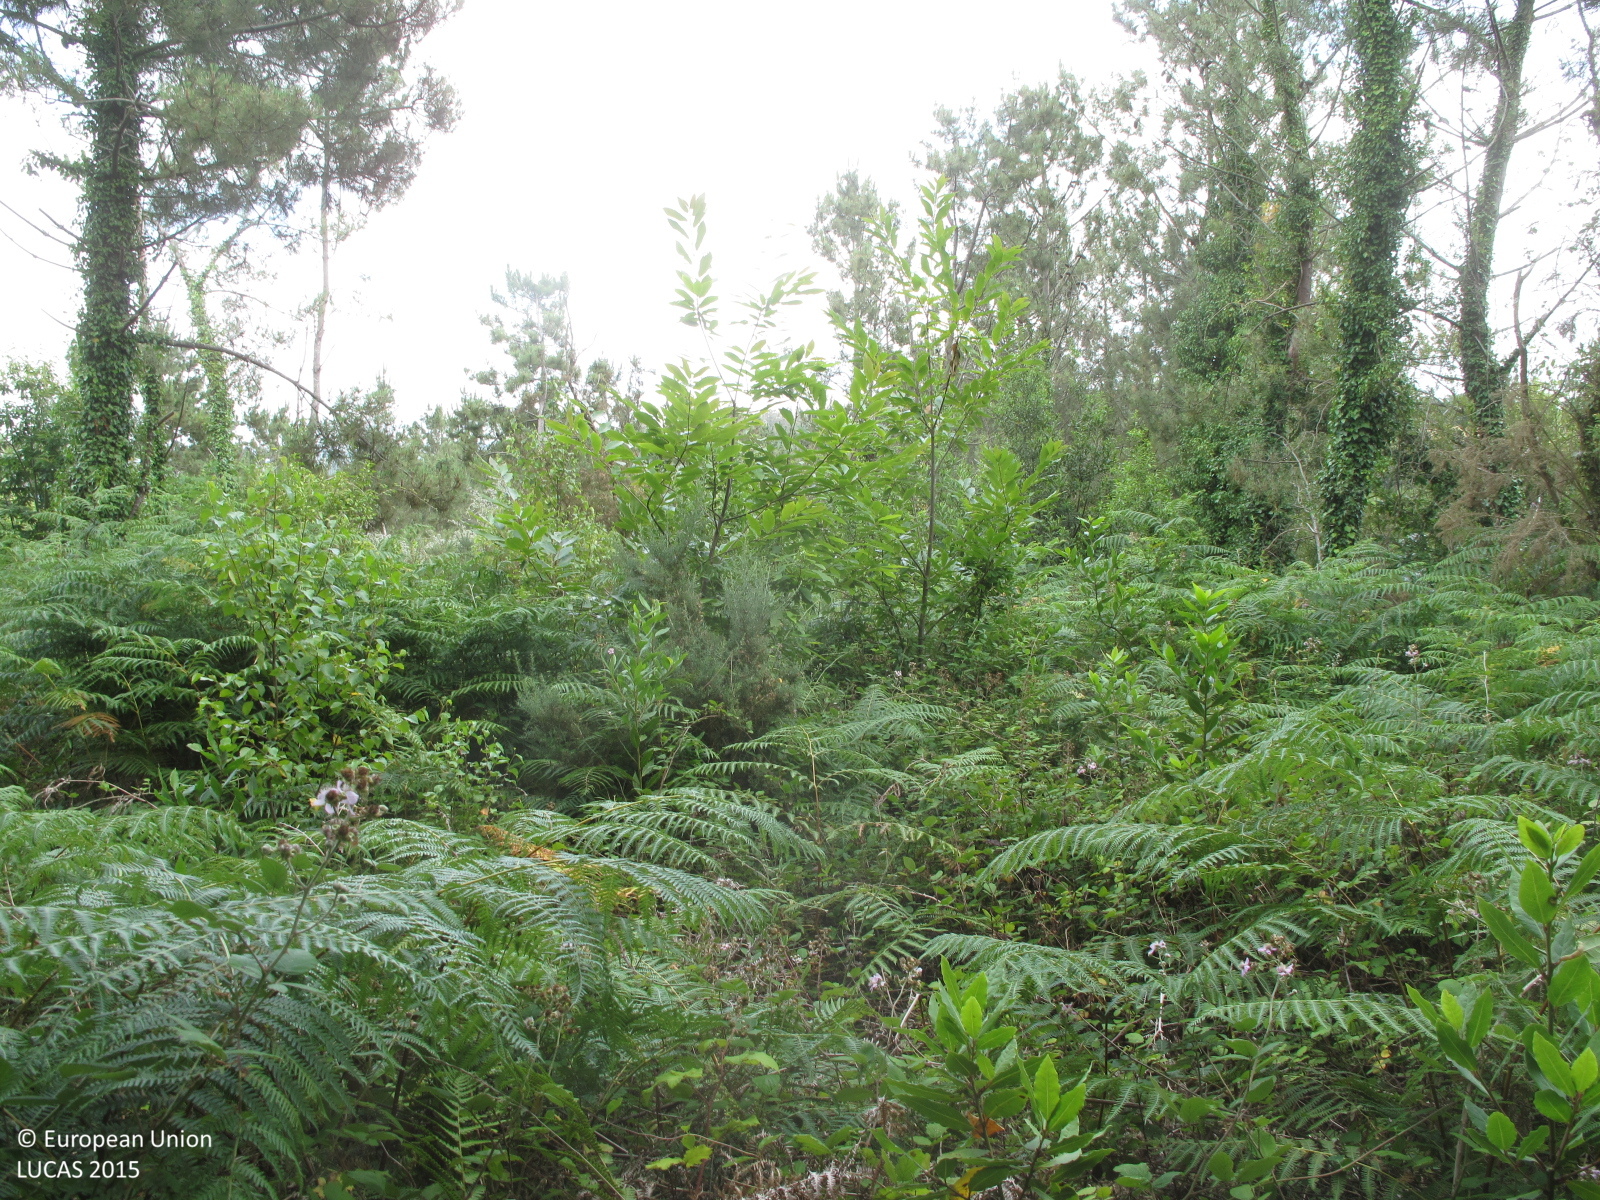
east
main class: Woodland
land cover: Broadleaved woodland
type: exotic forest
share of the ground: 25 - 50 %
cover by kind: shrubs 60 %, broadleaved forest trees 30 %, herbaceous plants 10 %
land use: Forestry
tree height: < 5 m
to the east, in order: Broadleaved woodland; Rivers and streams; Broadleaved woodland; Pine dominated mixed woodland; Broadleaved woodland
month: July
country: ES
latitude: 43.5173
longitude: -7.9971
